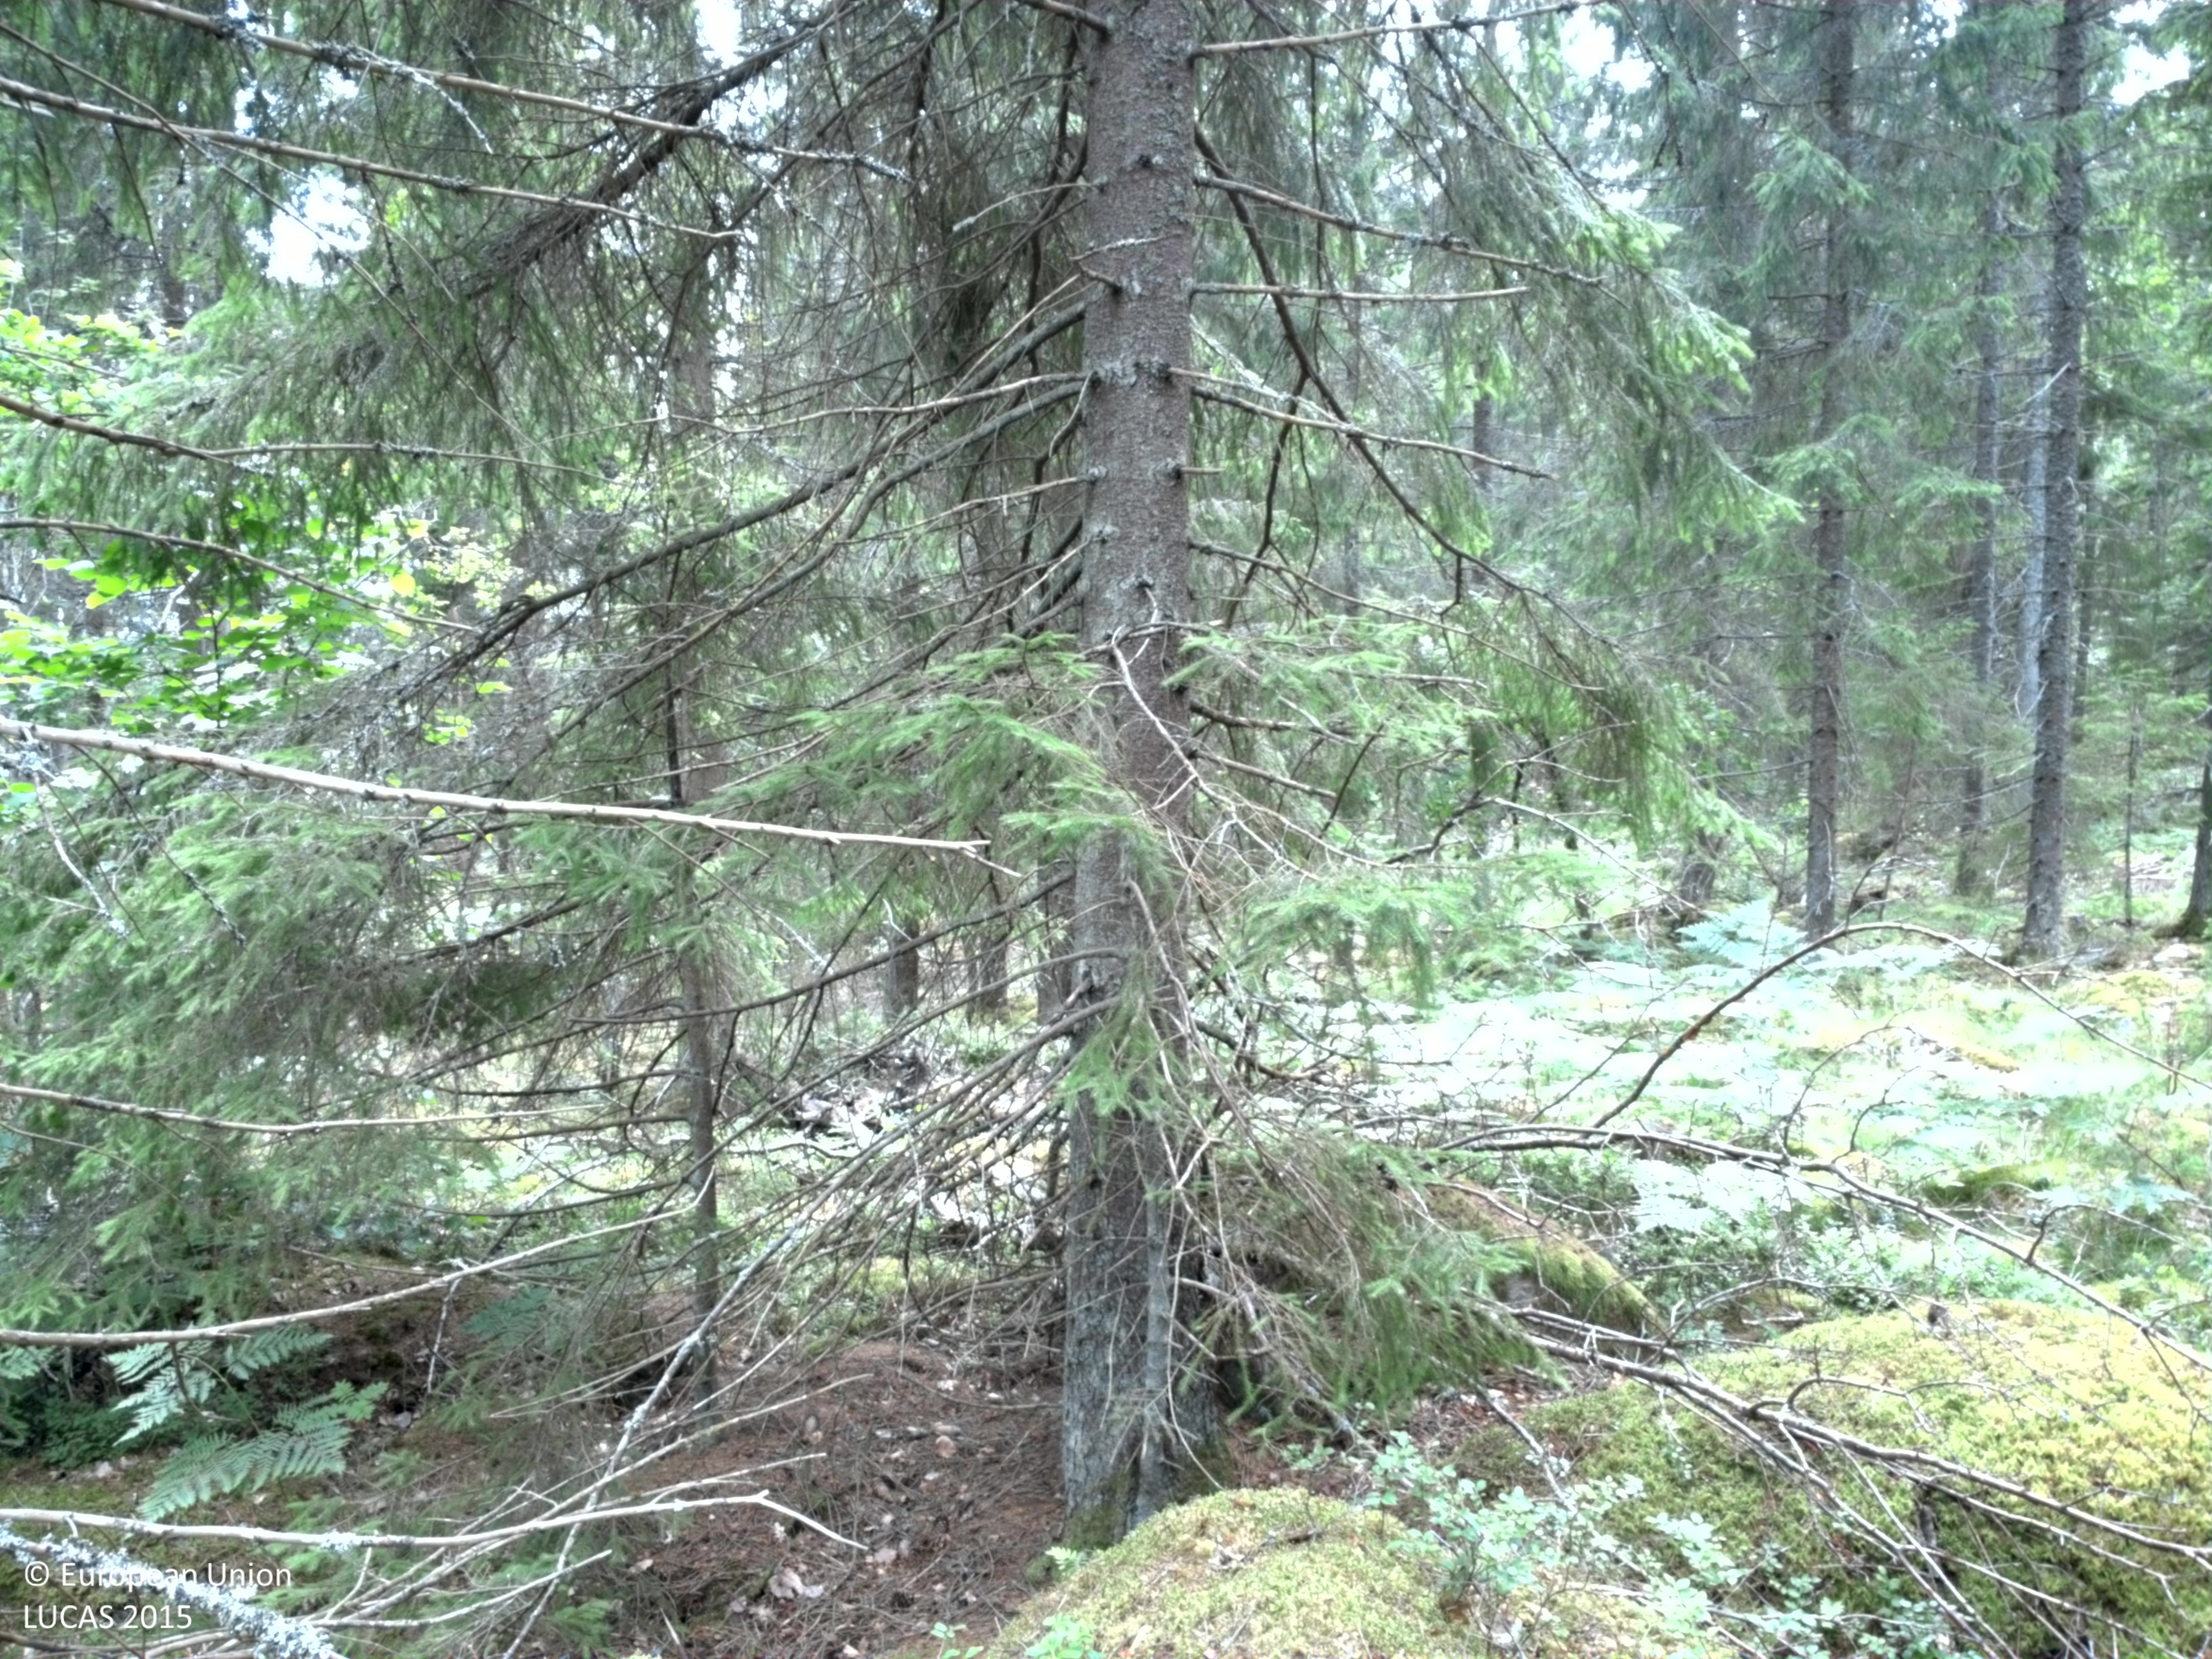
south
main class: Woodland
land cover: Spruce dominated coniferous woodland
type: boreal forest
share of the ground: > 75 %
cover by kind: coniferous forest trees 70 %, broadleaved forest trees 15 %, lichens and mosses 15 %
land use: Forestry
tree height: > 5 m
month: July
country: SE
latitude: 59.8128
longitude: 18.5391
